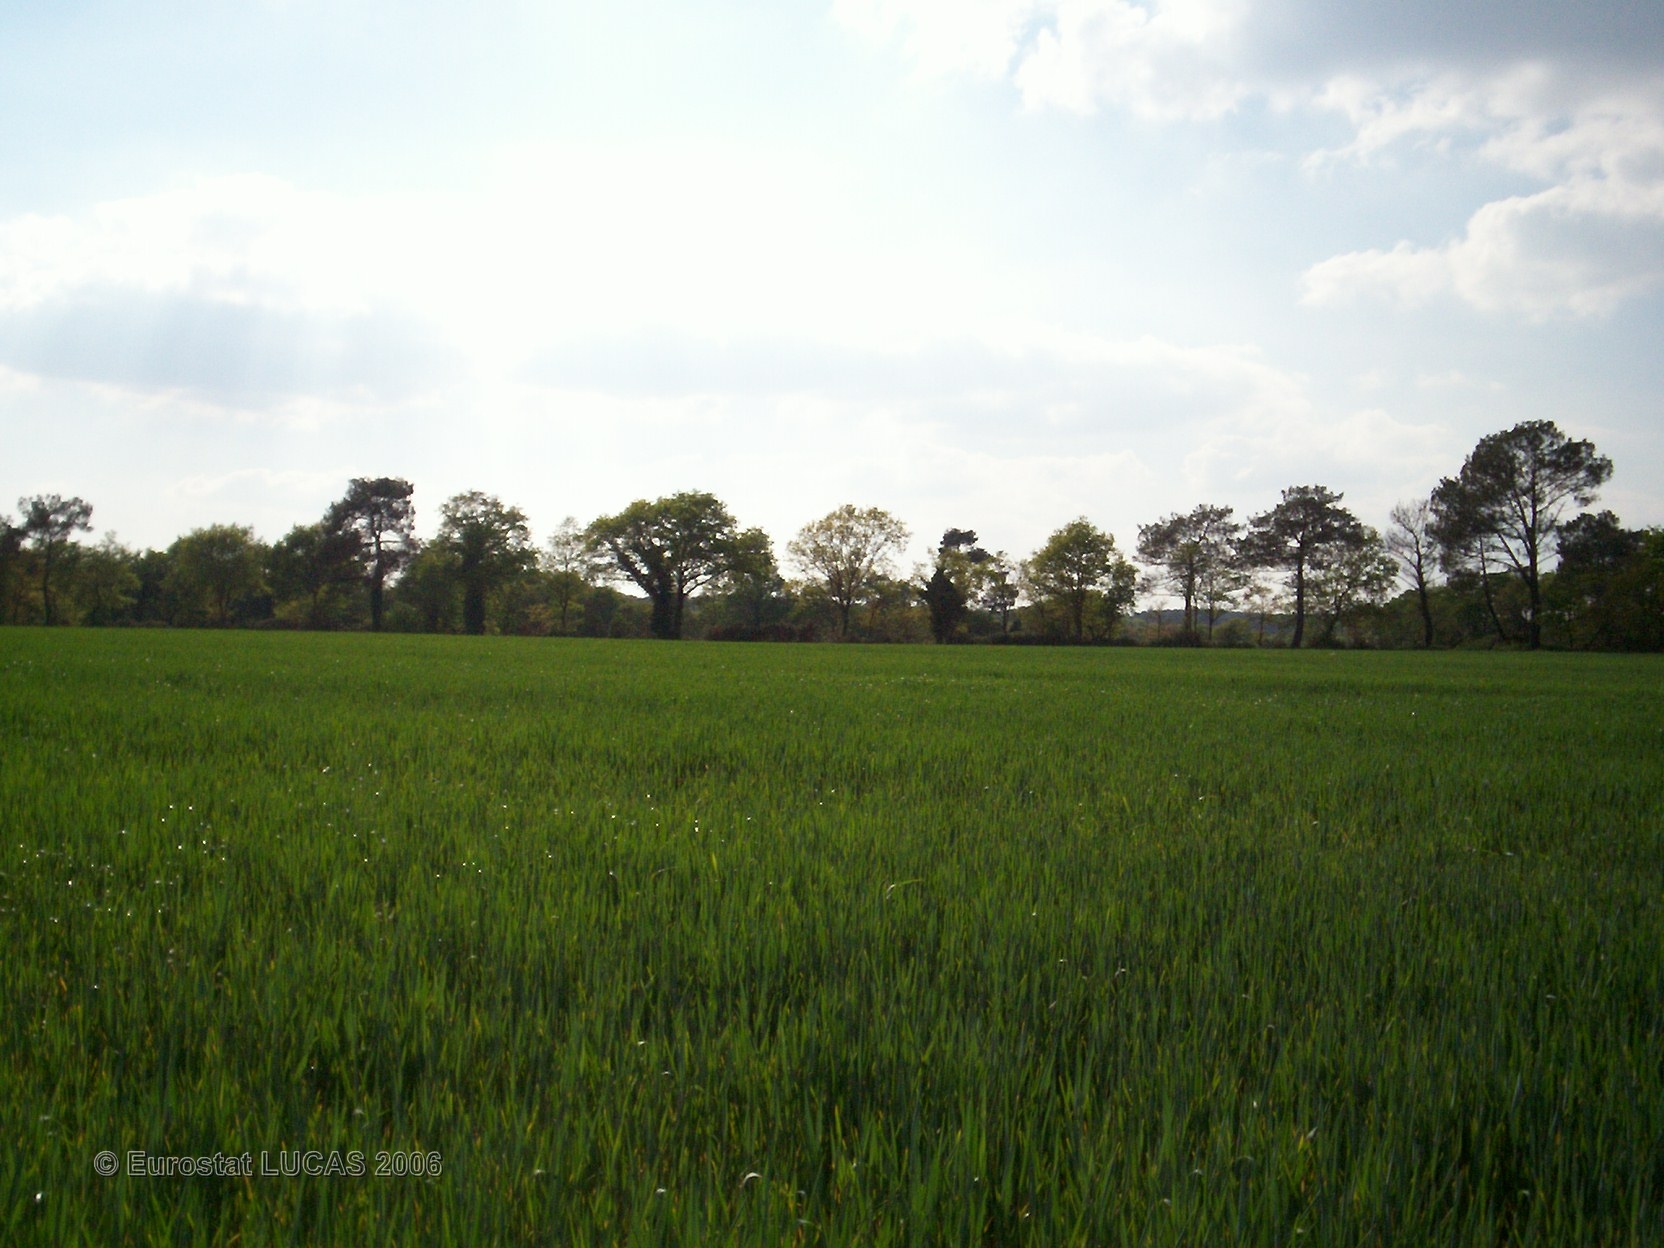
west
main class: Cropland
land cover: Common wheat
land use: Agriculture (excluding fallow land and kitchen gardens)
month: May
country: FR
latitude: 47.5884
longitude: -2.5985
